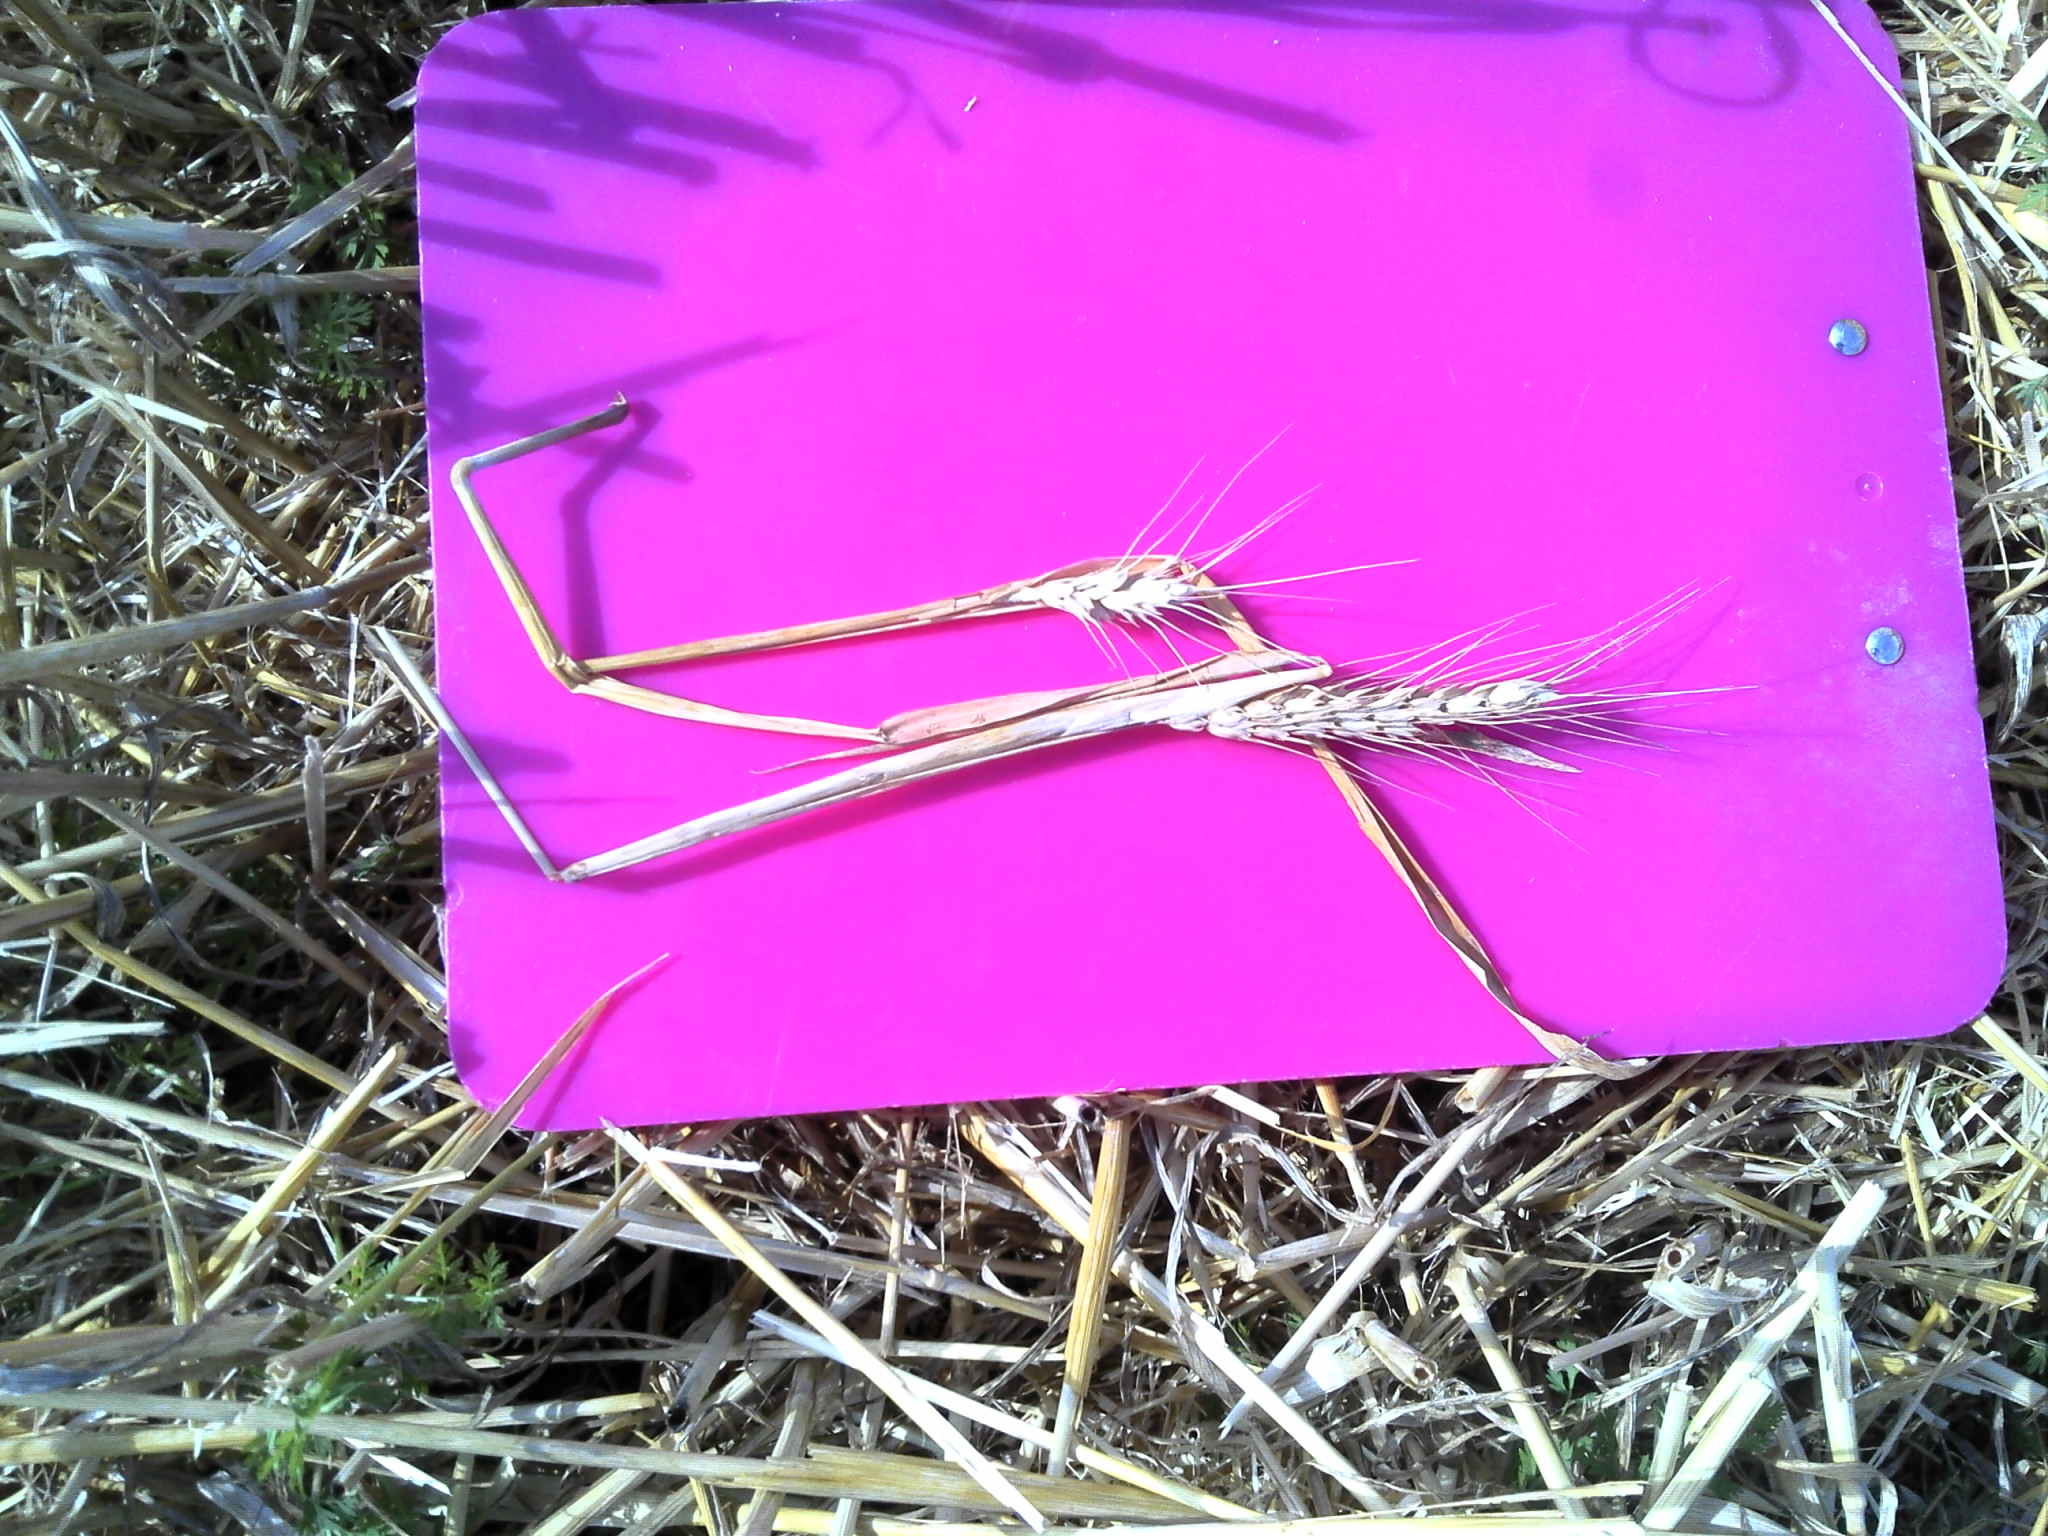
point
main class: Cropland
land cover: Common wheat
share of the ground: > 75 %
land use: Agriculture (excluding fallow land and kitchen gardens)
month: July
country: FR
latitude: 46.6826
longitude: 1.5040
